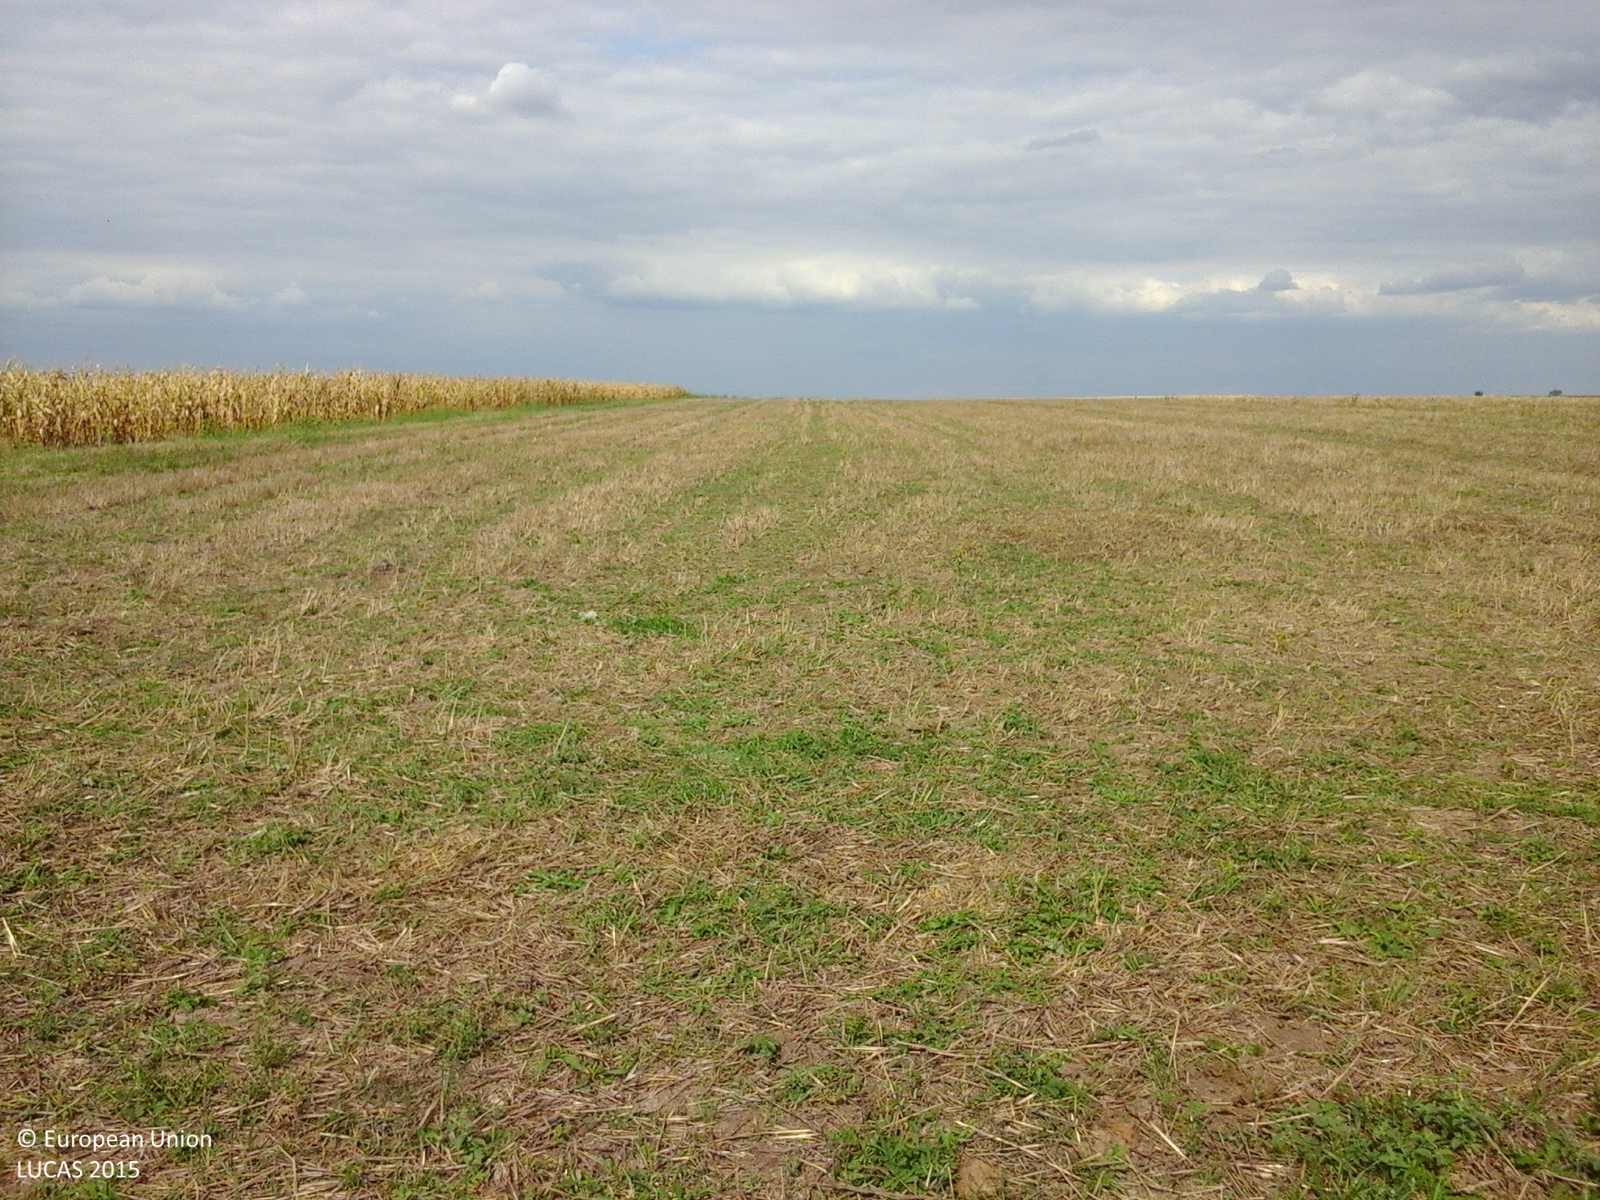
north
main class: Grassland
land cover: Grassland without tree/shrub cover
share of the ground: > 75 %
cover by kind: herbaceous plants 100 %
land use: Agriculture (excluding fallow land and kitchen gardens)
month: September
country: RO
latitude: 47.4852
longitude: 22.5461
